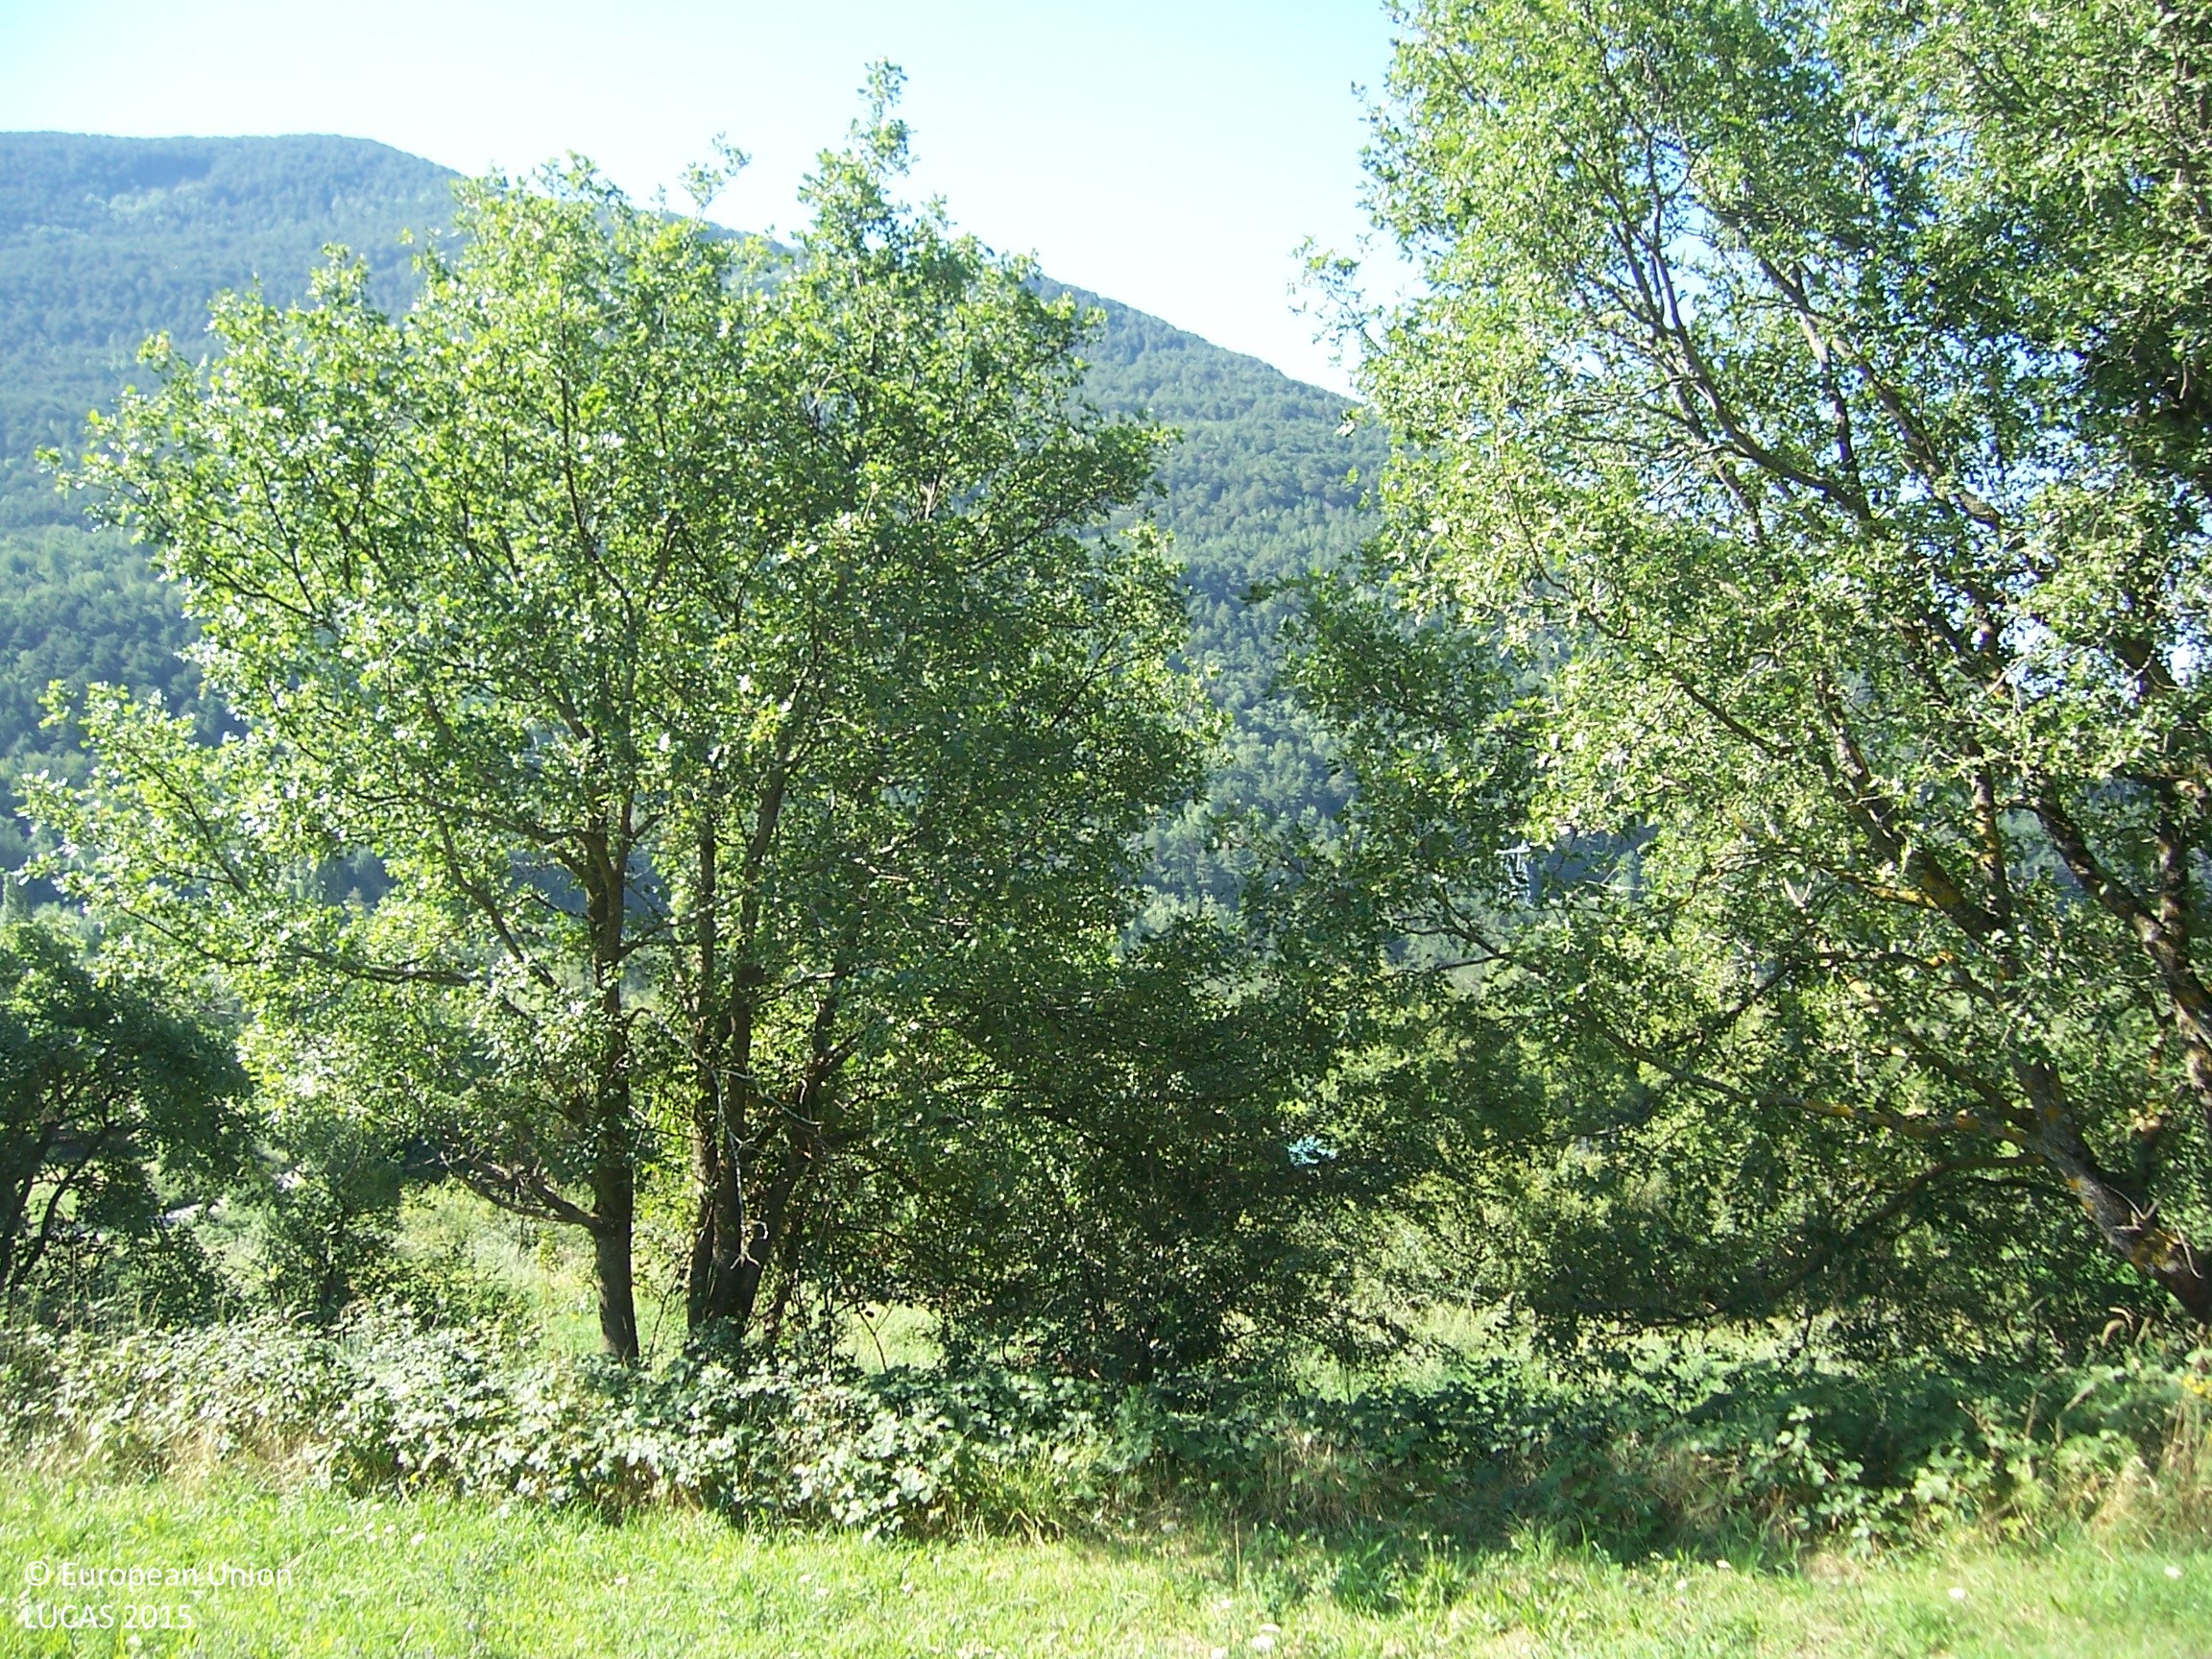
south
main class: Grassland
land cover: Grassland without tree/shrub cover
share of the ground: > 75 %
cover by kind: herbaceous plants 100 %
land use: Agriculture (excluding fallow land and kitchen gardens)
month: August
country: ES
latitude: 42.6184
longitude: -0.3032
